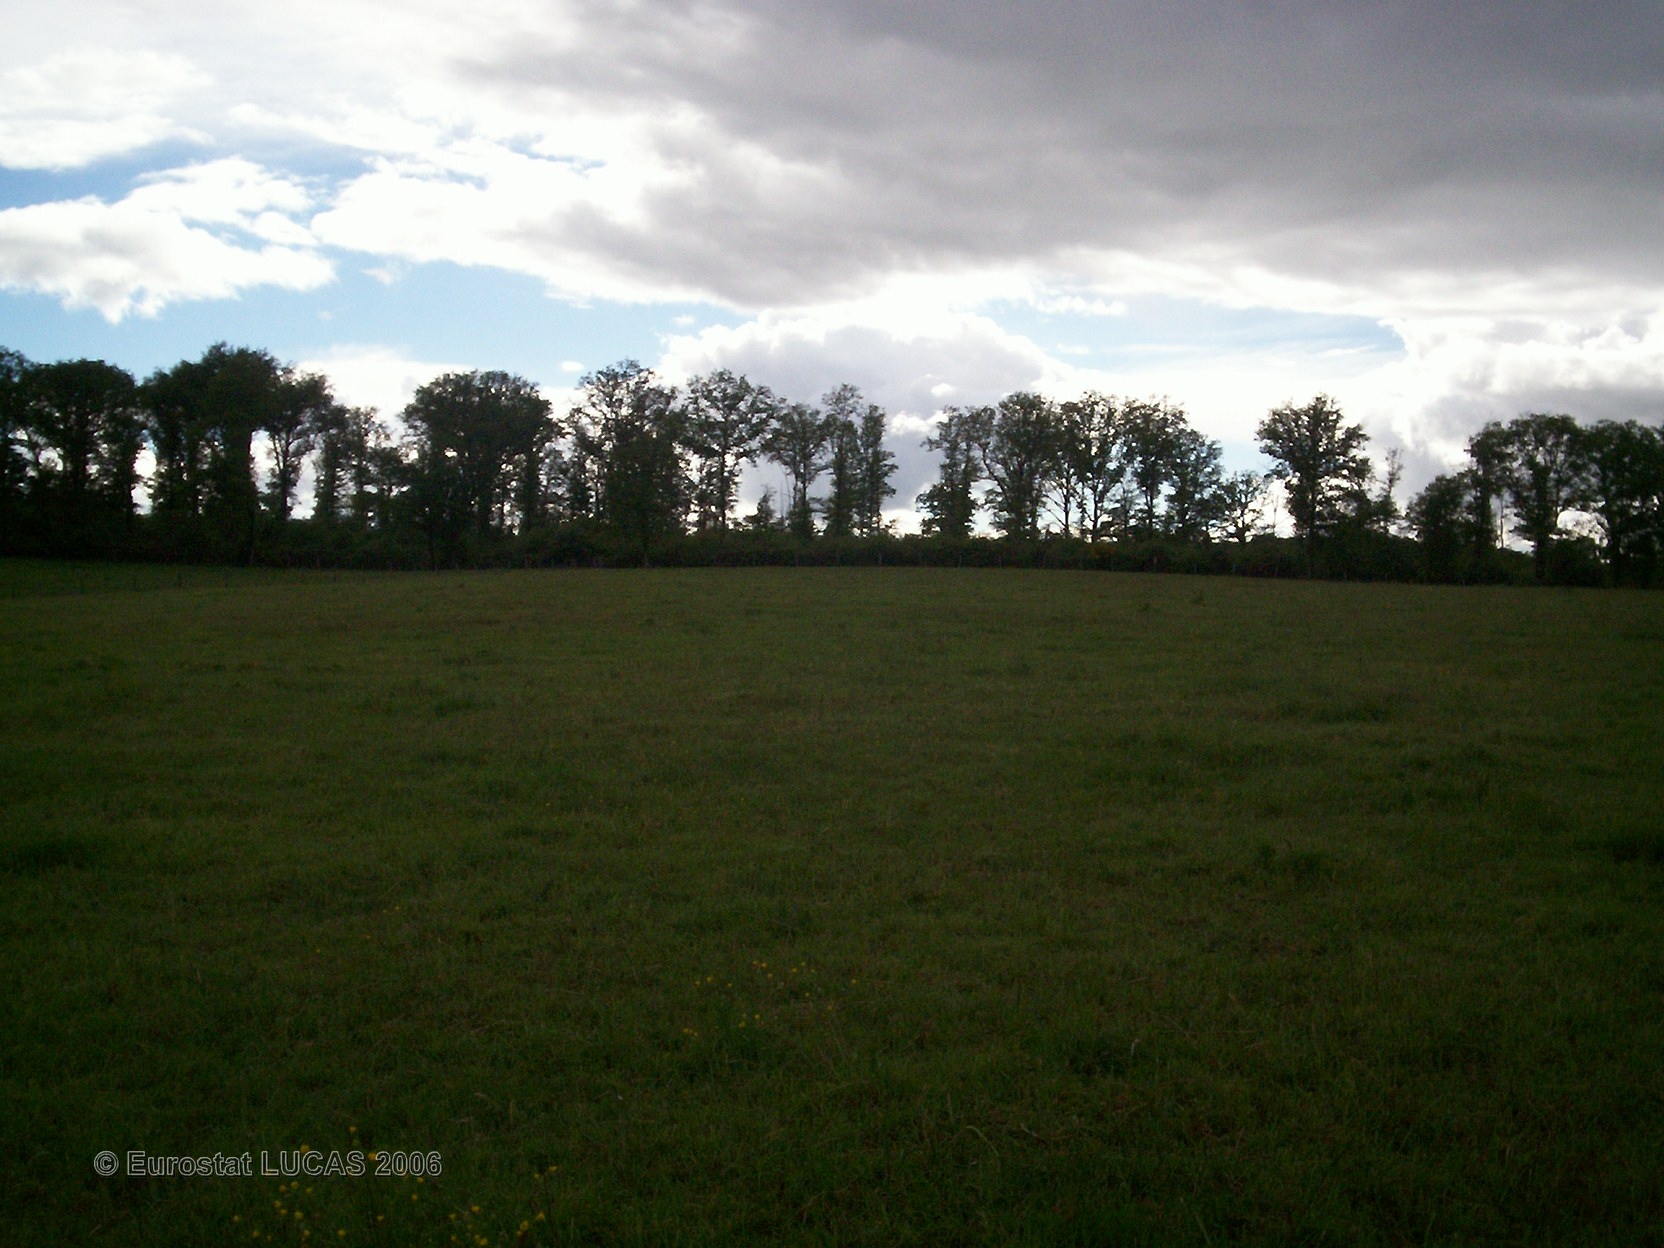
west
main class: Grassland
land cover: Grassland without tree/shrub cover
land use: Agriculture (excluding fallow land and kitchen gardens)
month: May
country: FR
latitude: 45.9460
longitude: 0.5036
